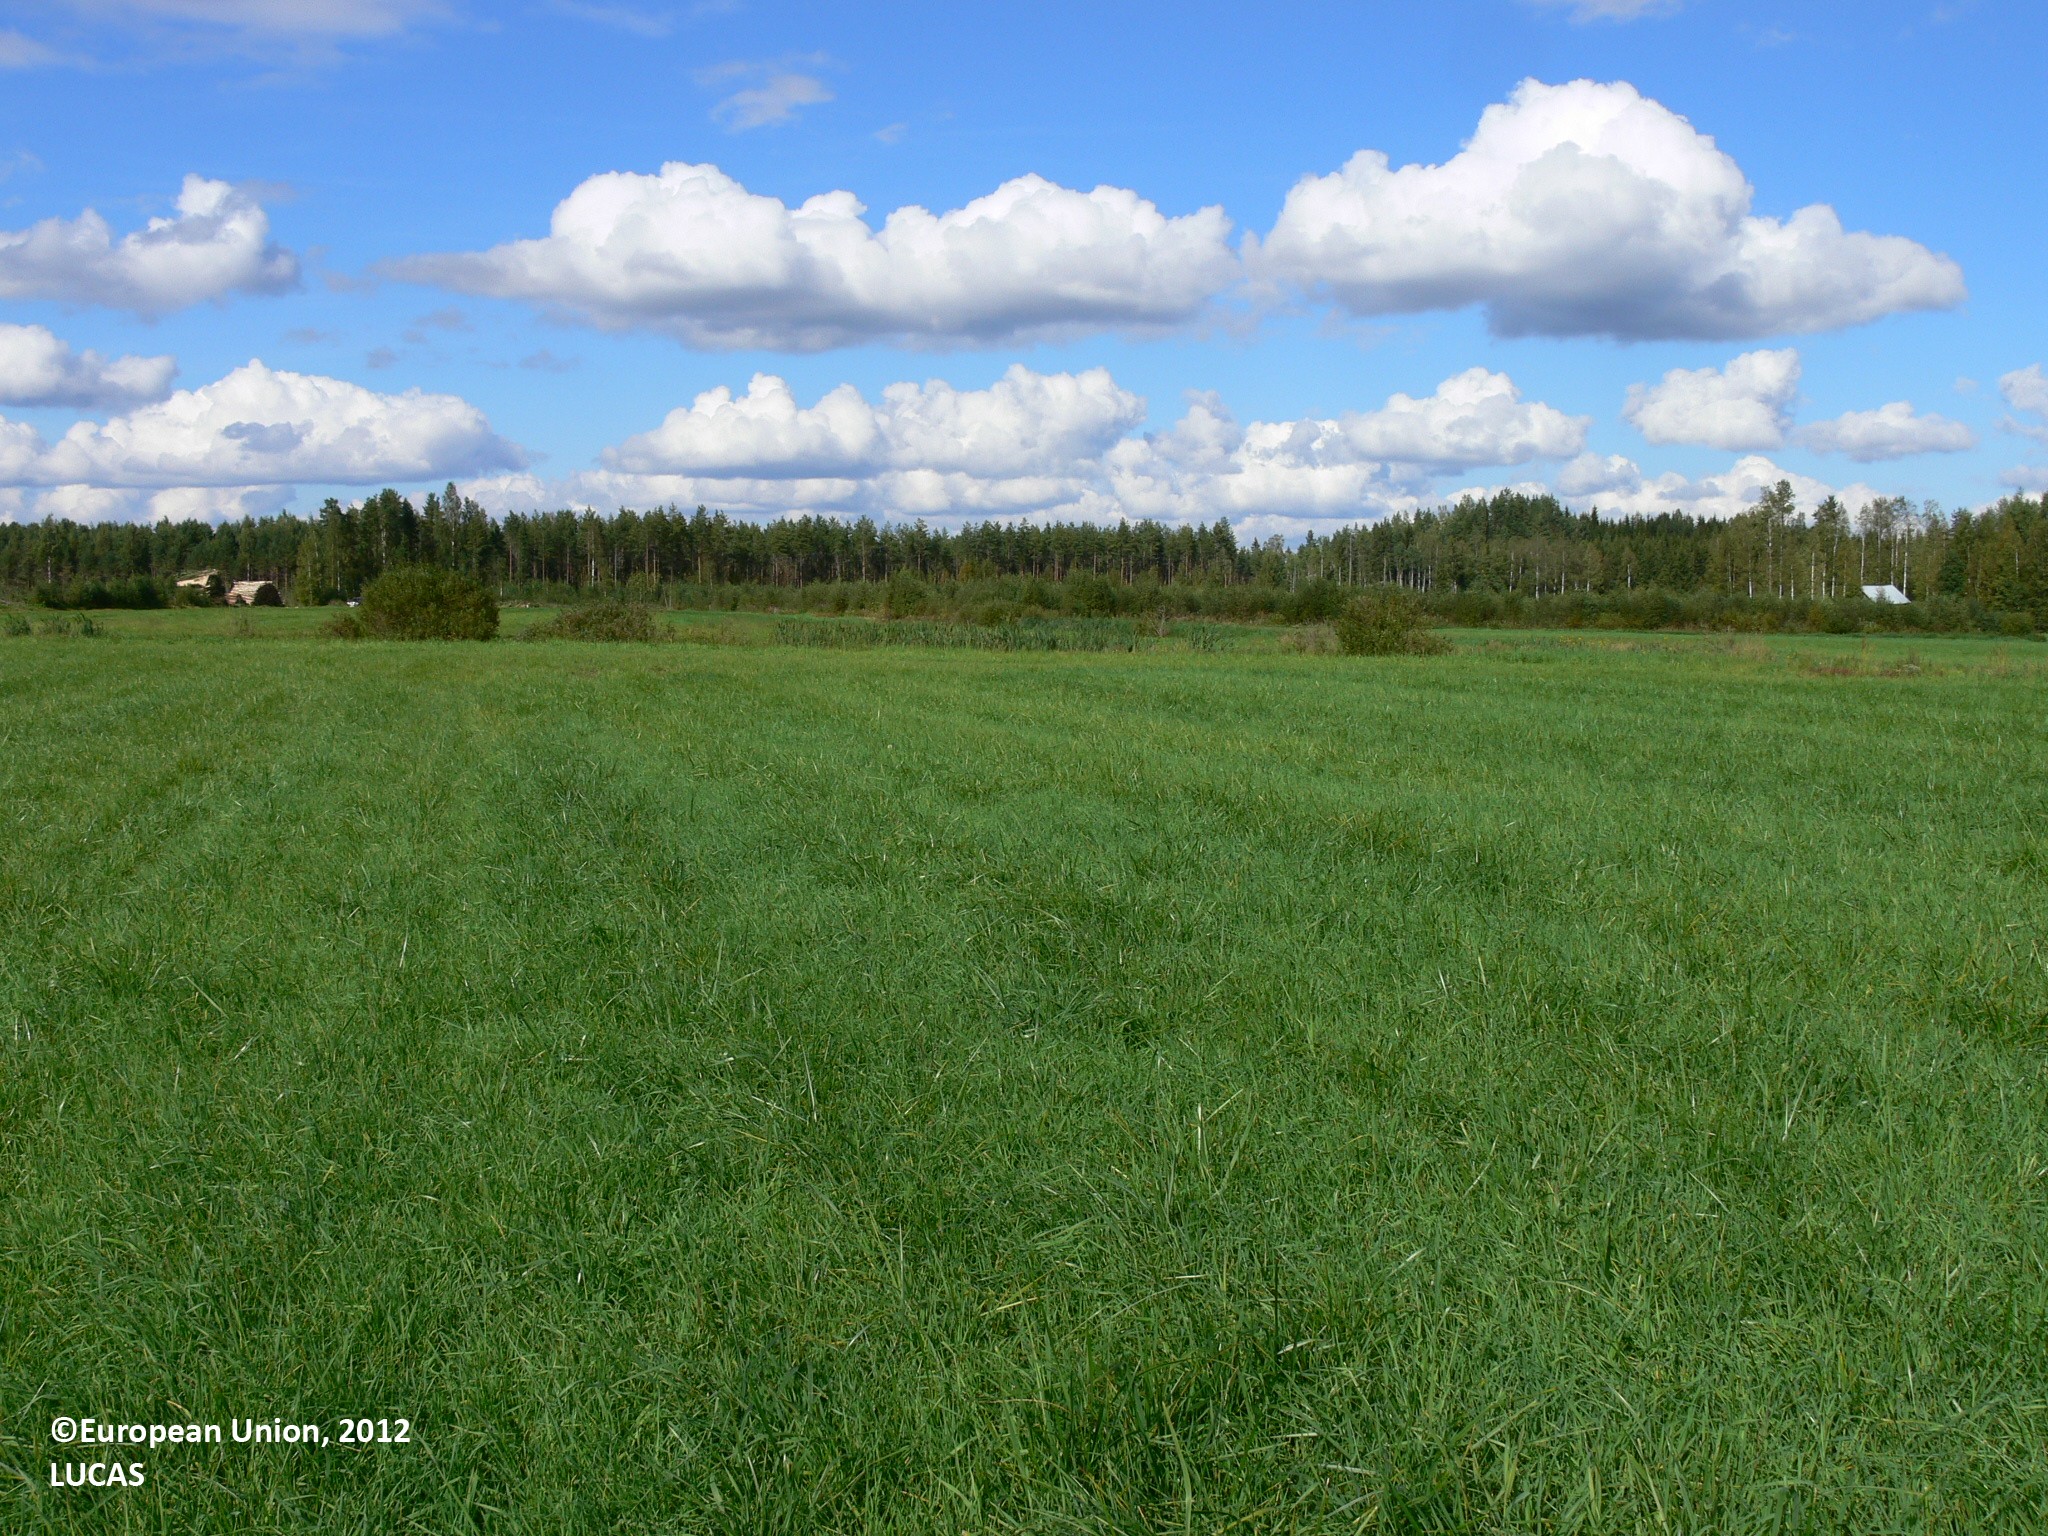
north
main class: Cropland
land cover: Temporary grasslands
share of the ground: > 75 %
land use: Agriculture (excluding fallow land and kitchen gardens)
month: August
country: FI
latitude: 62.0742
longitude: 30.2392
